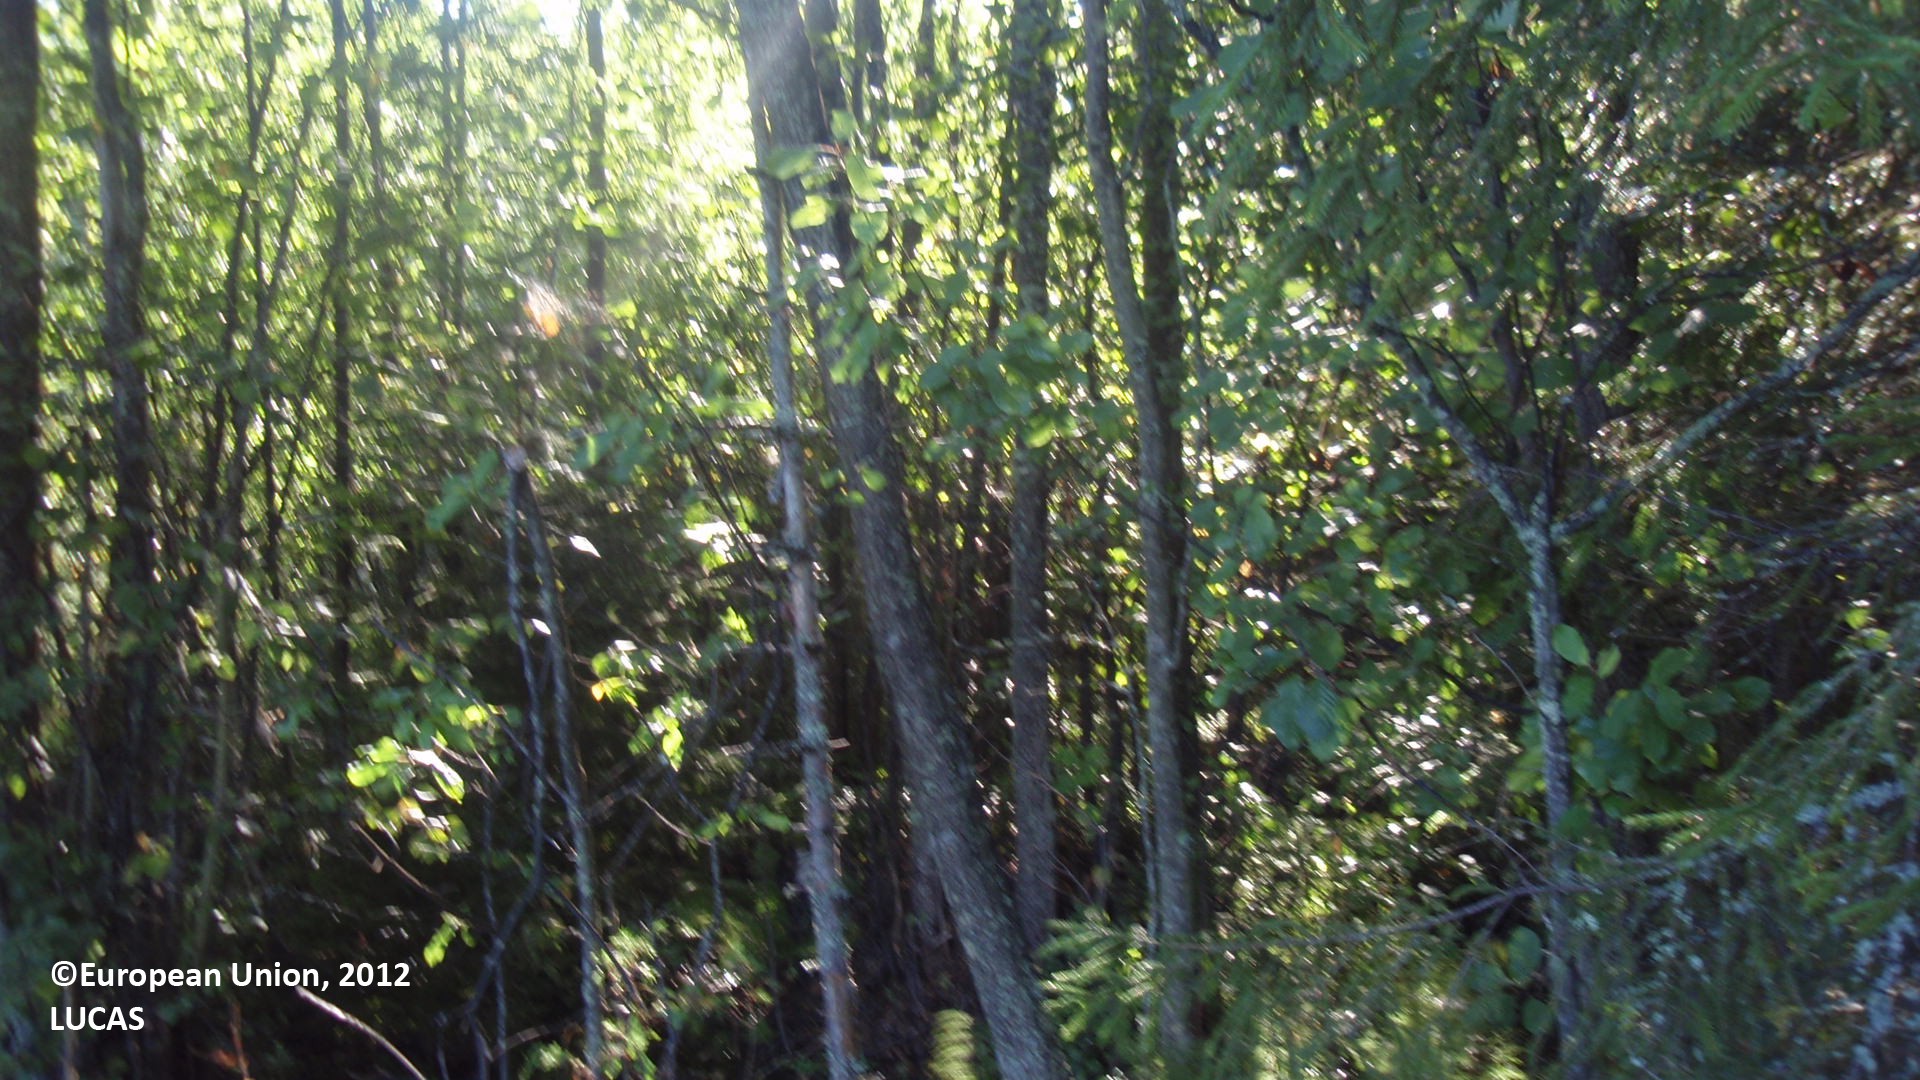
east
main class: Woodland
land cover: Broadleaved woodland
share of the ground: 50 - 75 %
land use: Forestry
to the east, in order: Broadleaved woodland; Spruce dominated mixed woodland; Electric lines; Spruce dominated coniferous woodland; Broadleaved woodland; Grassland with sparse tree/shrub cover; Broadleaved woodland
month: August
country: FI
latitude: 61.5315
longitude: 27.8473
